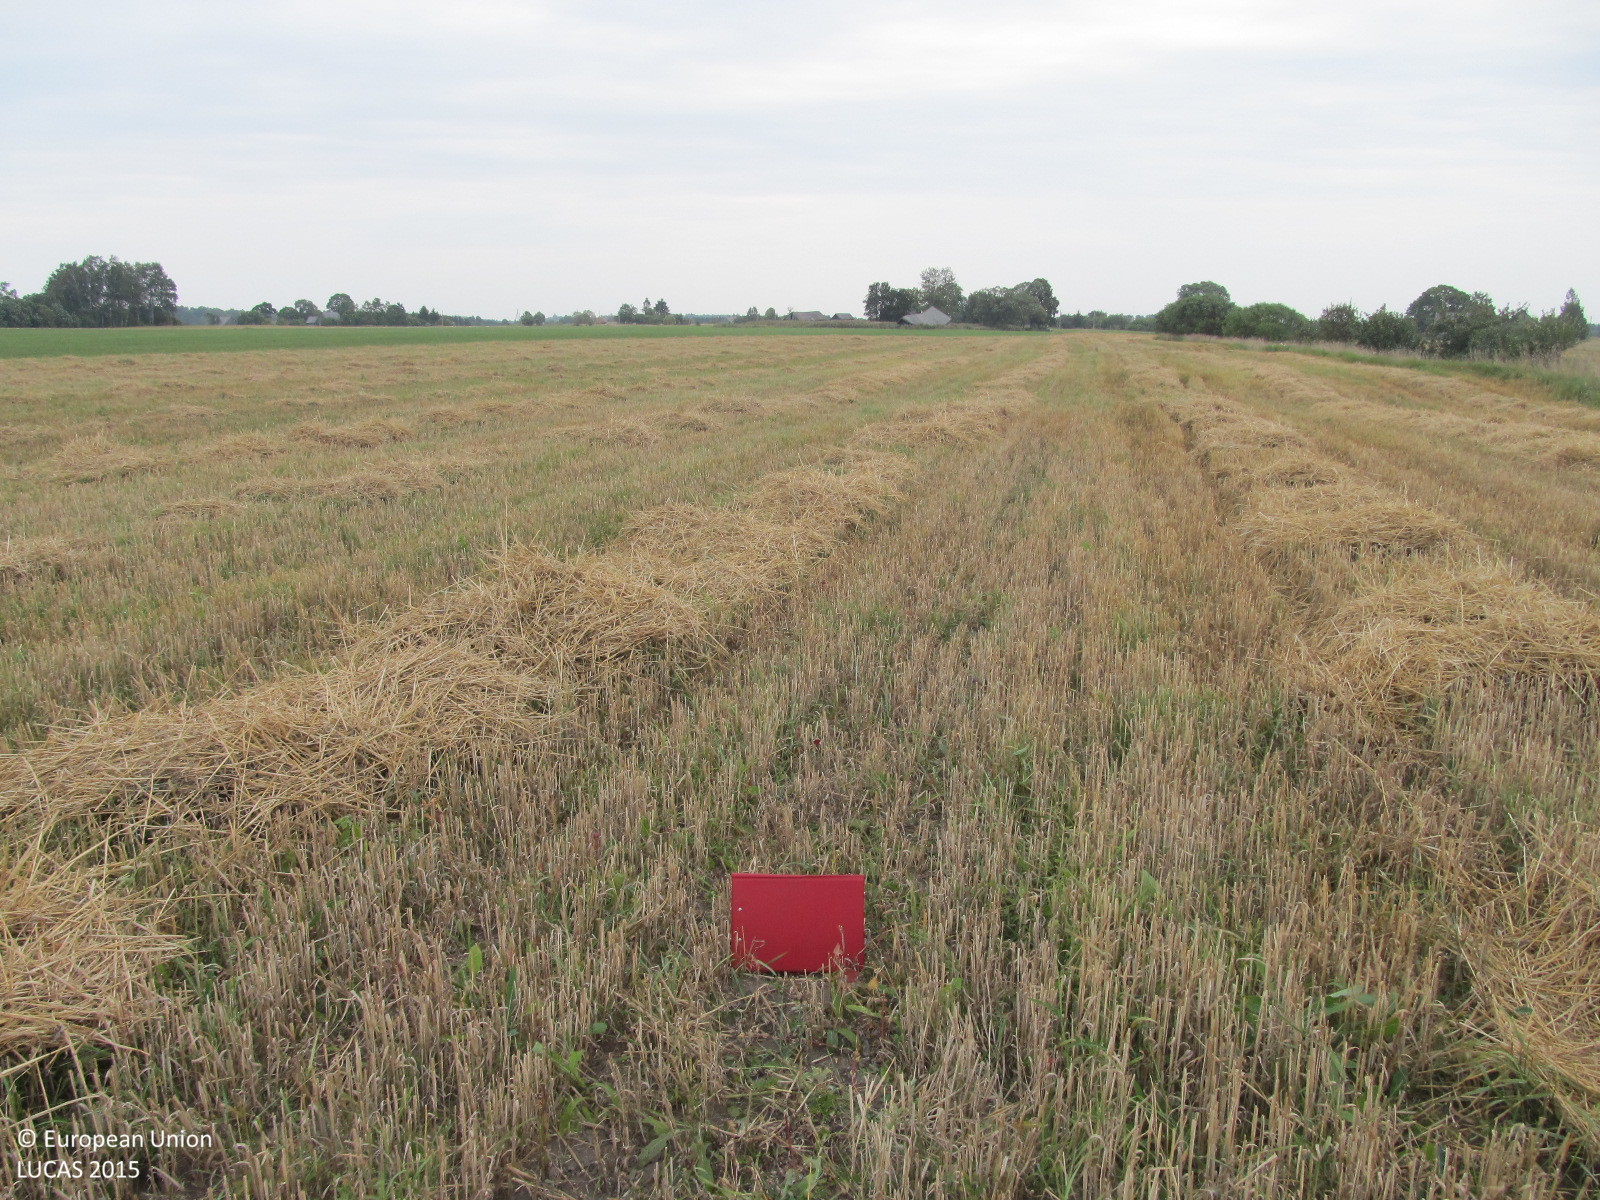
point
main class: Cropland
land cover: Common wheat
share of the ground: > 75 %
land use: Agriculture (excluding fallow land and kitchen gardens)
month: August
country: LT
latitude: 55.6275
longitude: 23.0457
